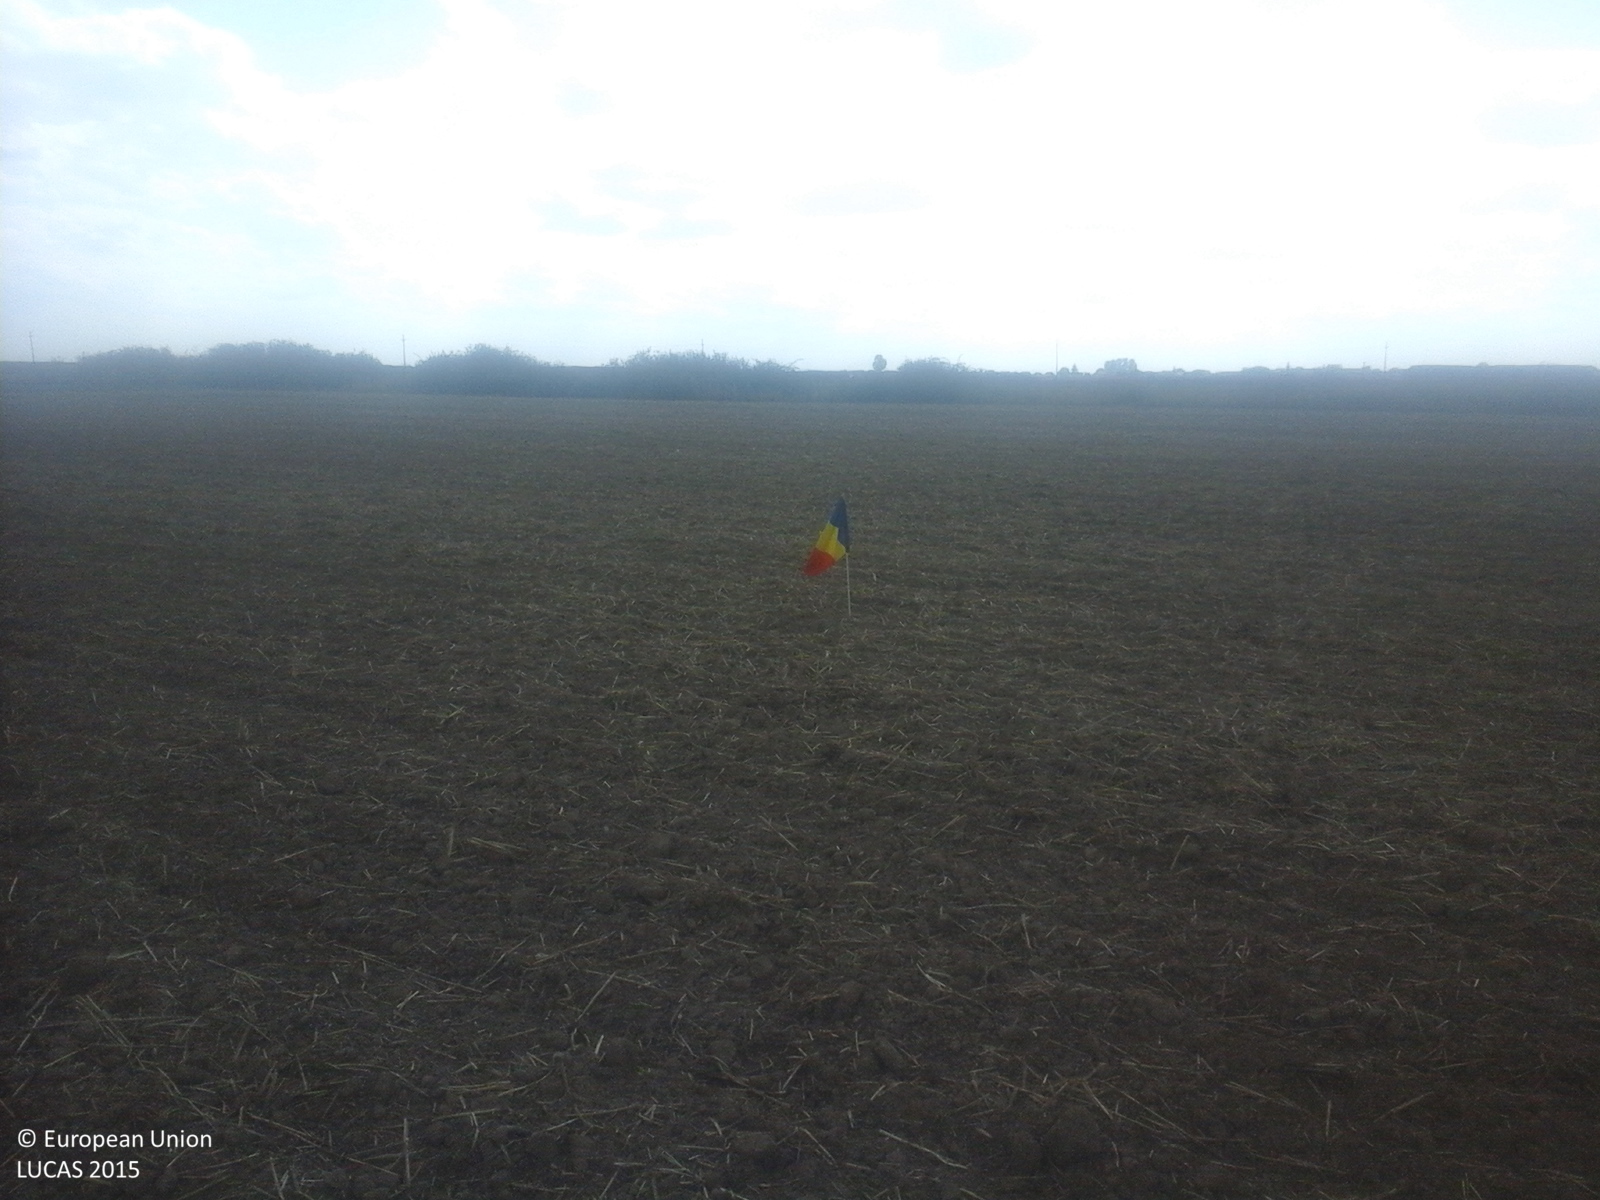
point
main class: Cropland
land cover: Common wheat
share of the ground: < 10 %
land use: Agriculture (excluding fallow land and kitchen gardens)
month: September
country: RO
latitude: 47.6885
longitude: 22.6775
